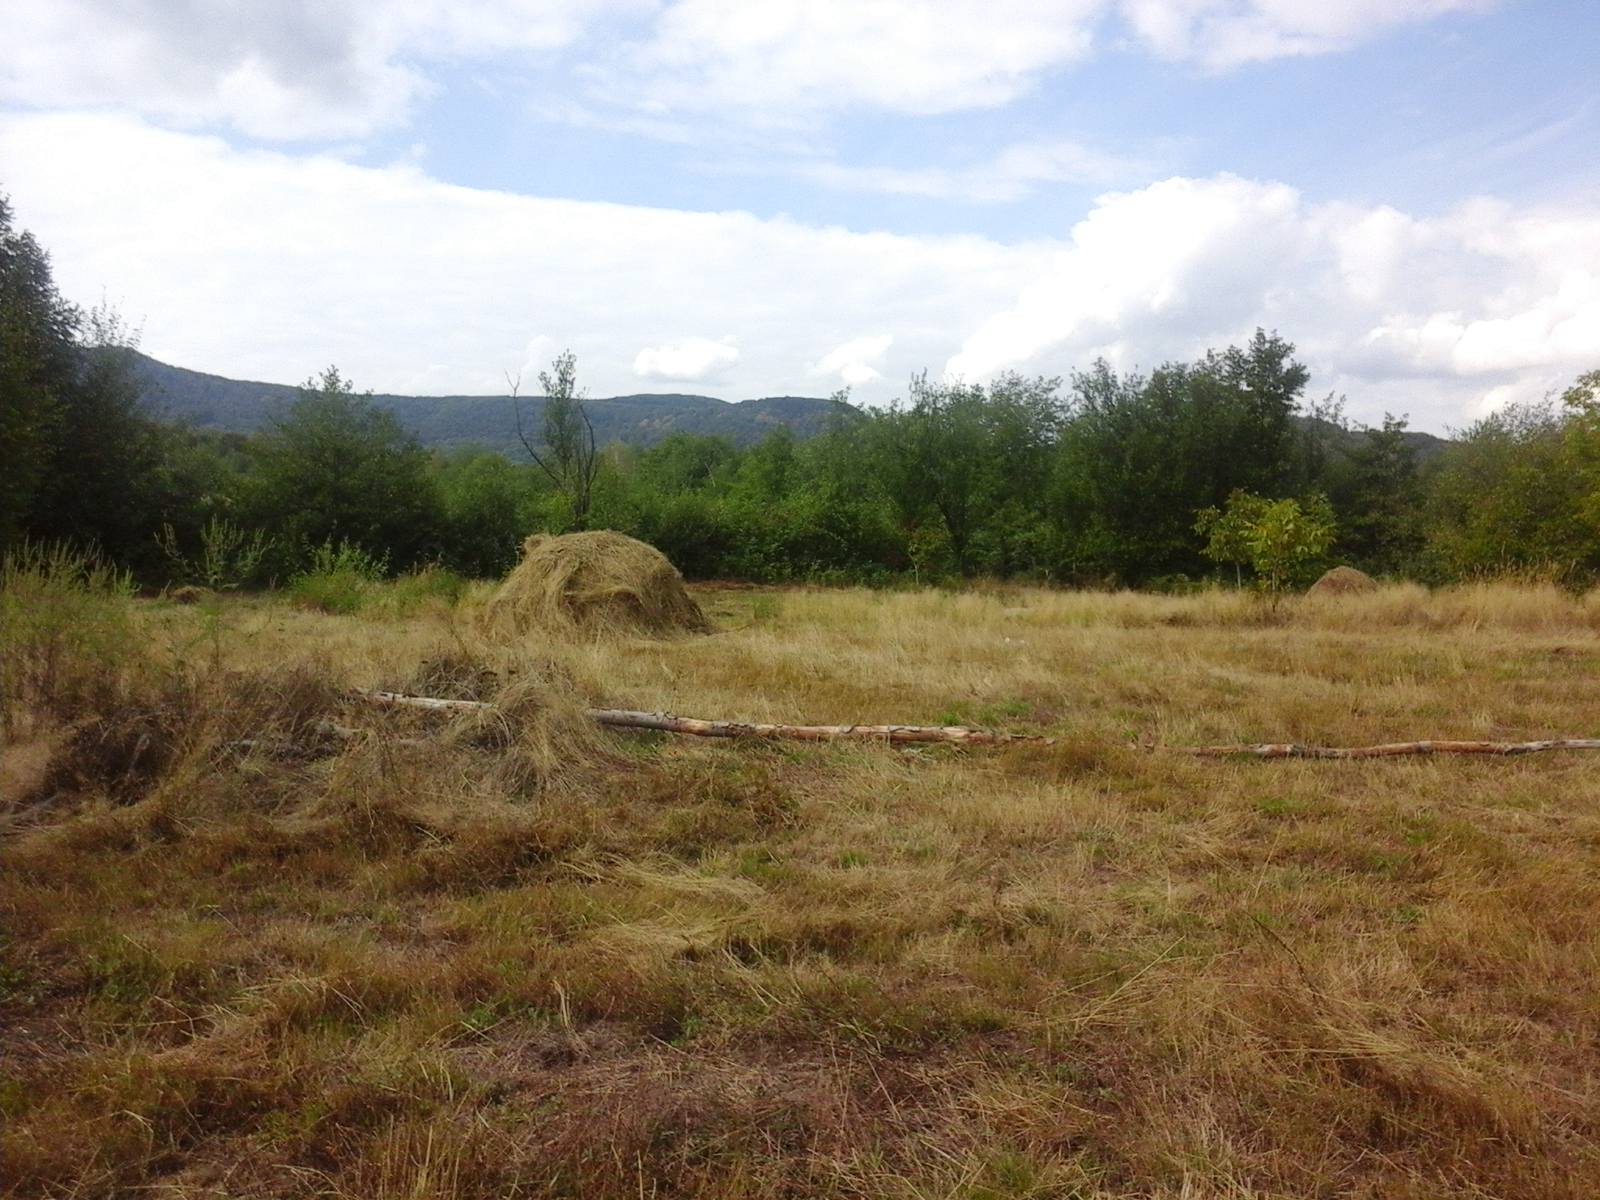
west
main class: Grassland
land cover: Grassland without tree/shrub cover
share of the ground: > 75 %
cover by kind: herbaceous plants 100 %
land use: Agriculture (excluding fallow land and kitchen gardens)
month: September
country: RO
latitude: 47.9791
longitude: 23.2958
